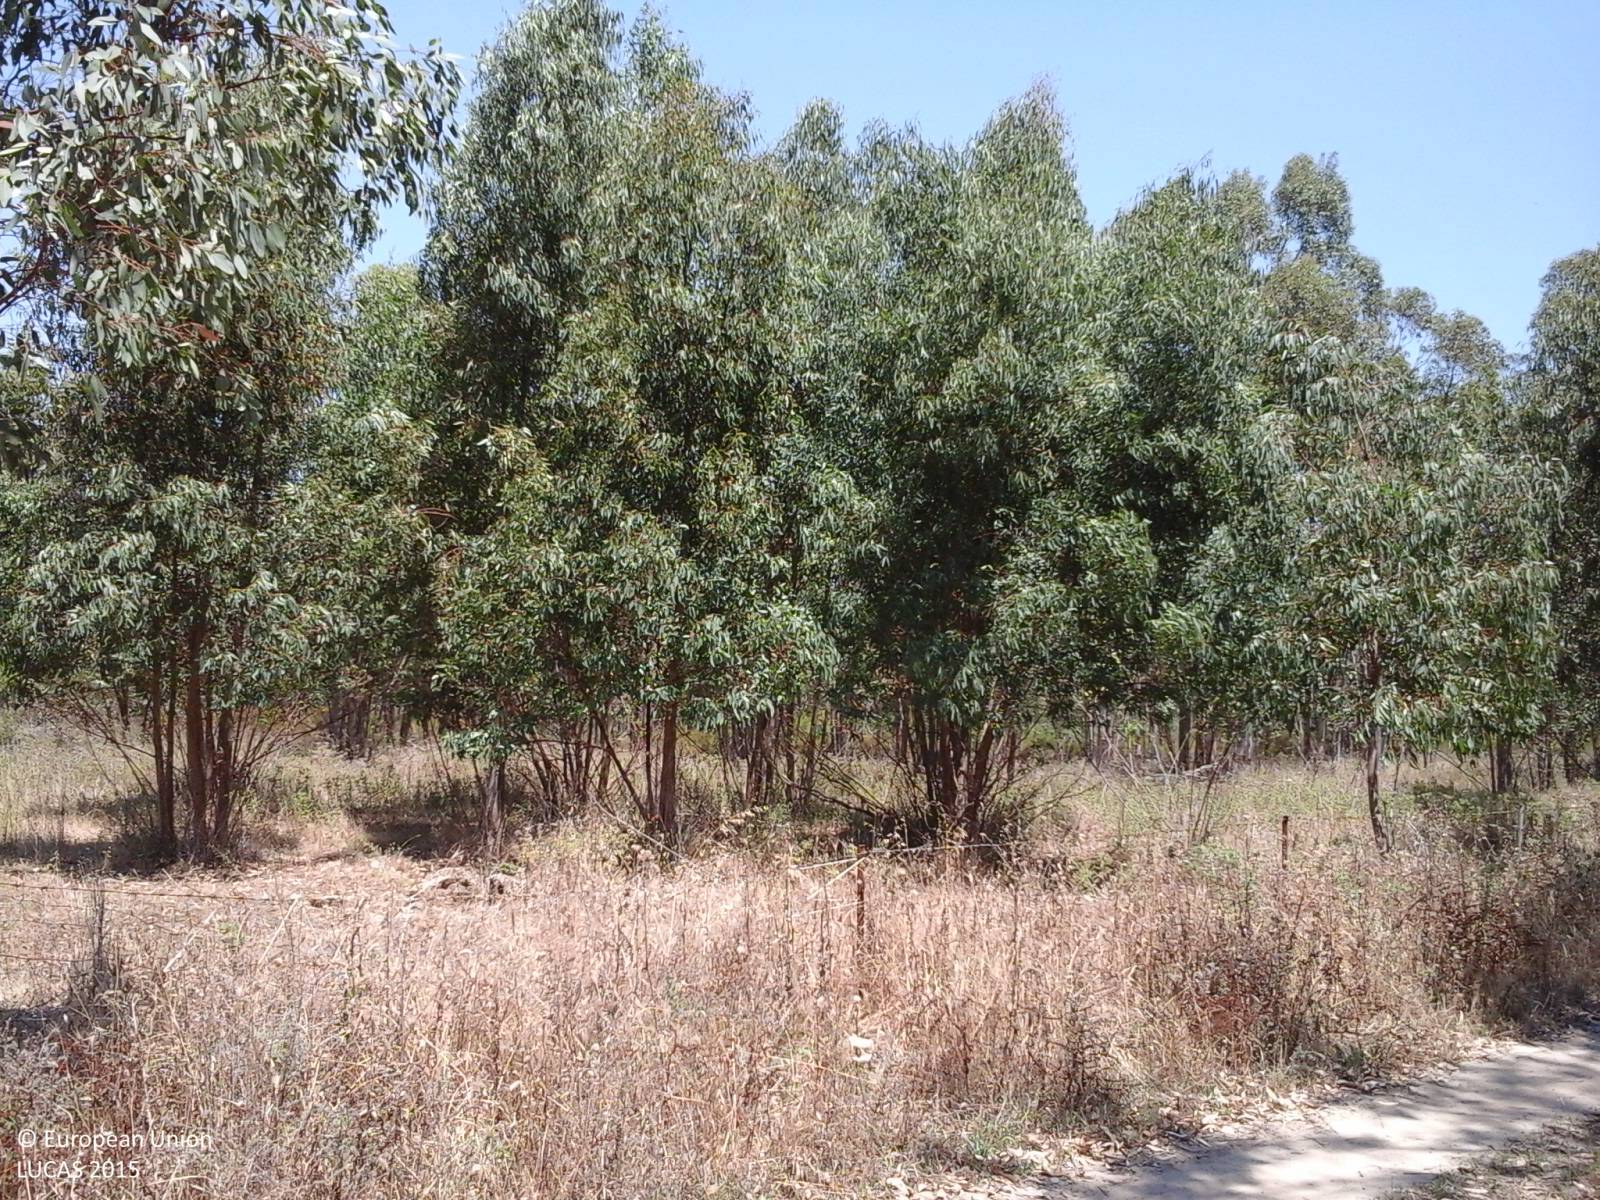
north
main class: Woodland
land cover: Broadleaved woodland
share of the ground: > 75 %
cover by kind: broadleaved forest trees 50 %, unconsolidated bare surface 40 %, herbaceous plants 10 %
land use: Agriculture (excluding fallow land and kitchen gardens)
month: June
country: IT
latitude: 39.8619
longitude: 8.8259
